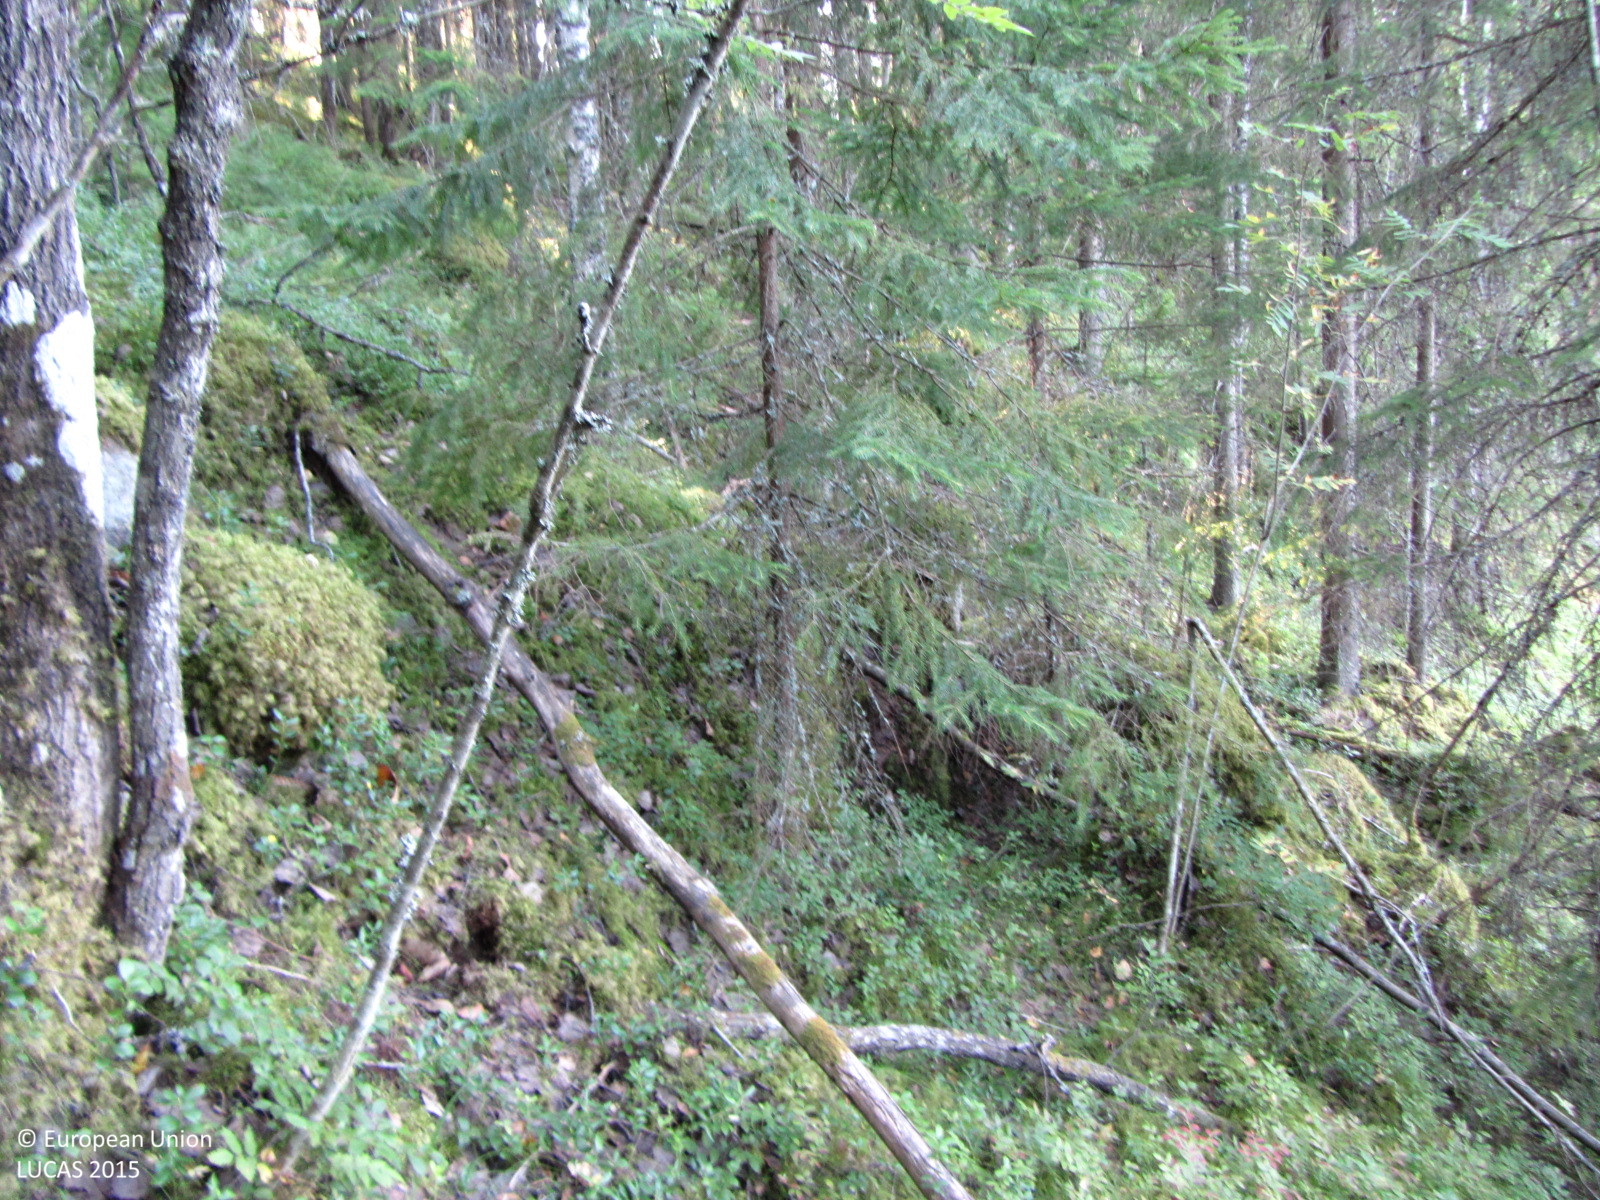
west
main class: Woodland
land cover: Spruce dominated mixed woodland
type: boreal forest
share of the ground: > 75 %
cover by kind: coniferous forest trees 50 %, broadleaved forest trees 30 %, shrubs 15 %, lichens and mosses 5 %
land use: Forestry
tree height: > 5 m
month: August
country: FI
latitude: 60.4419
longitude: 23.8876
